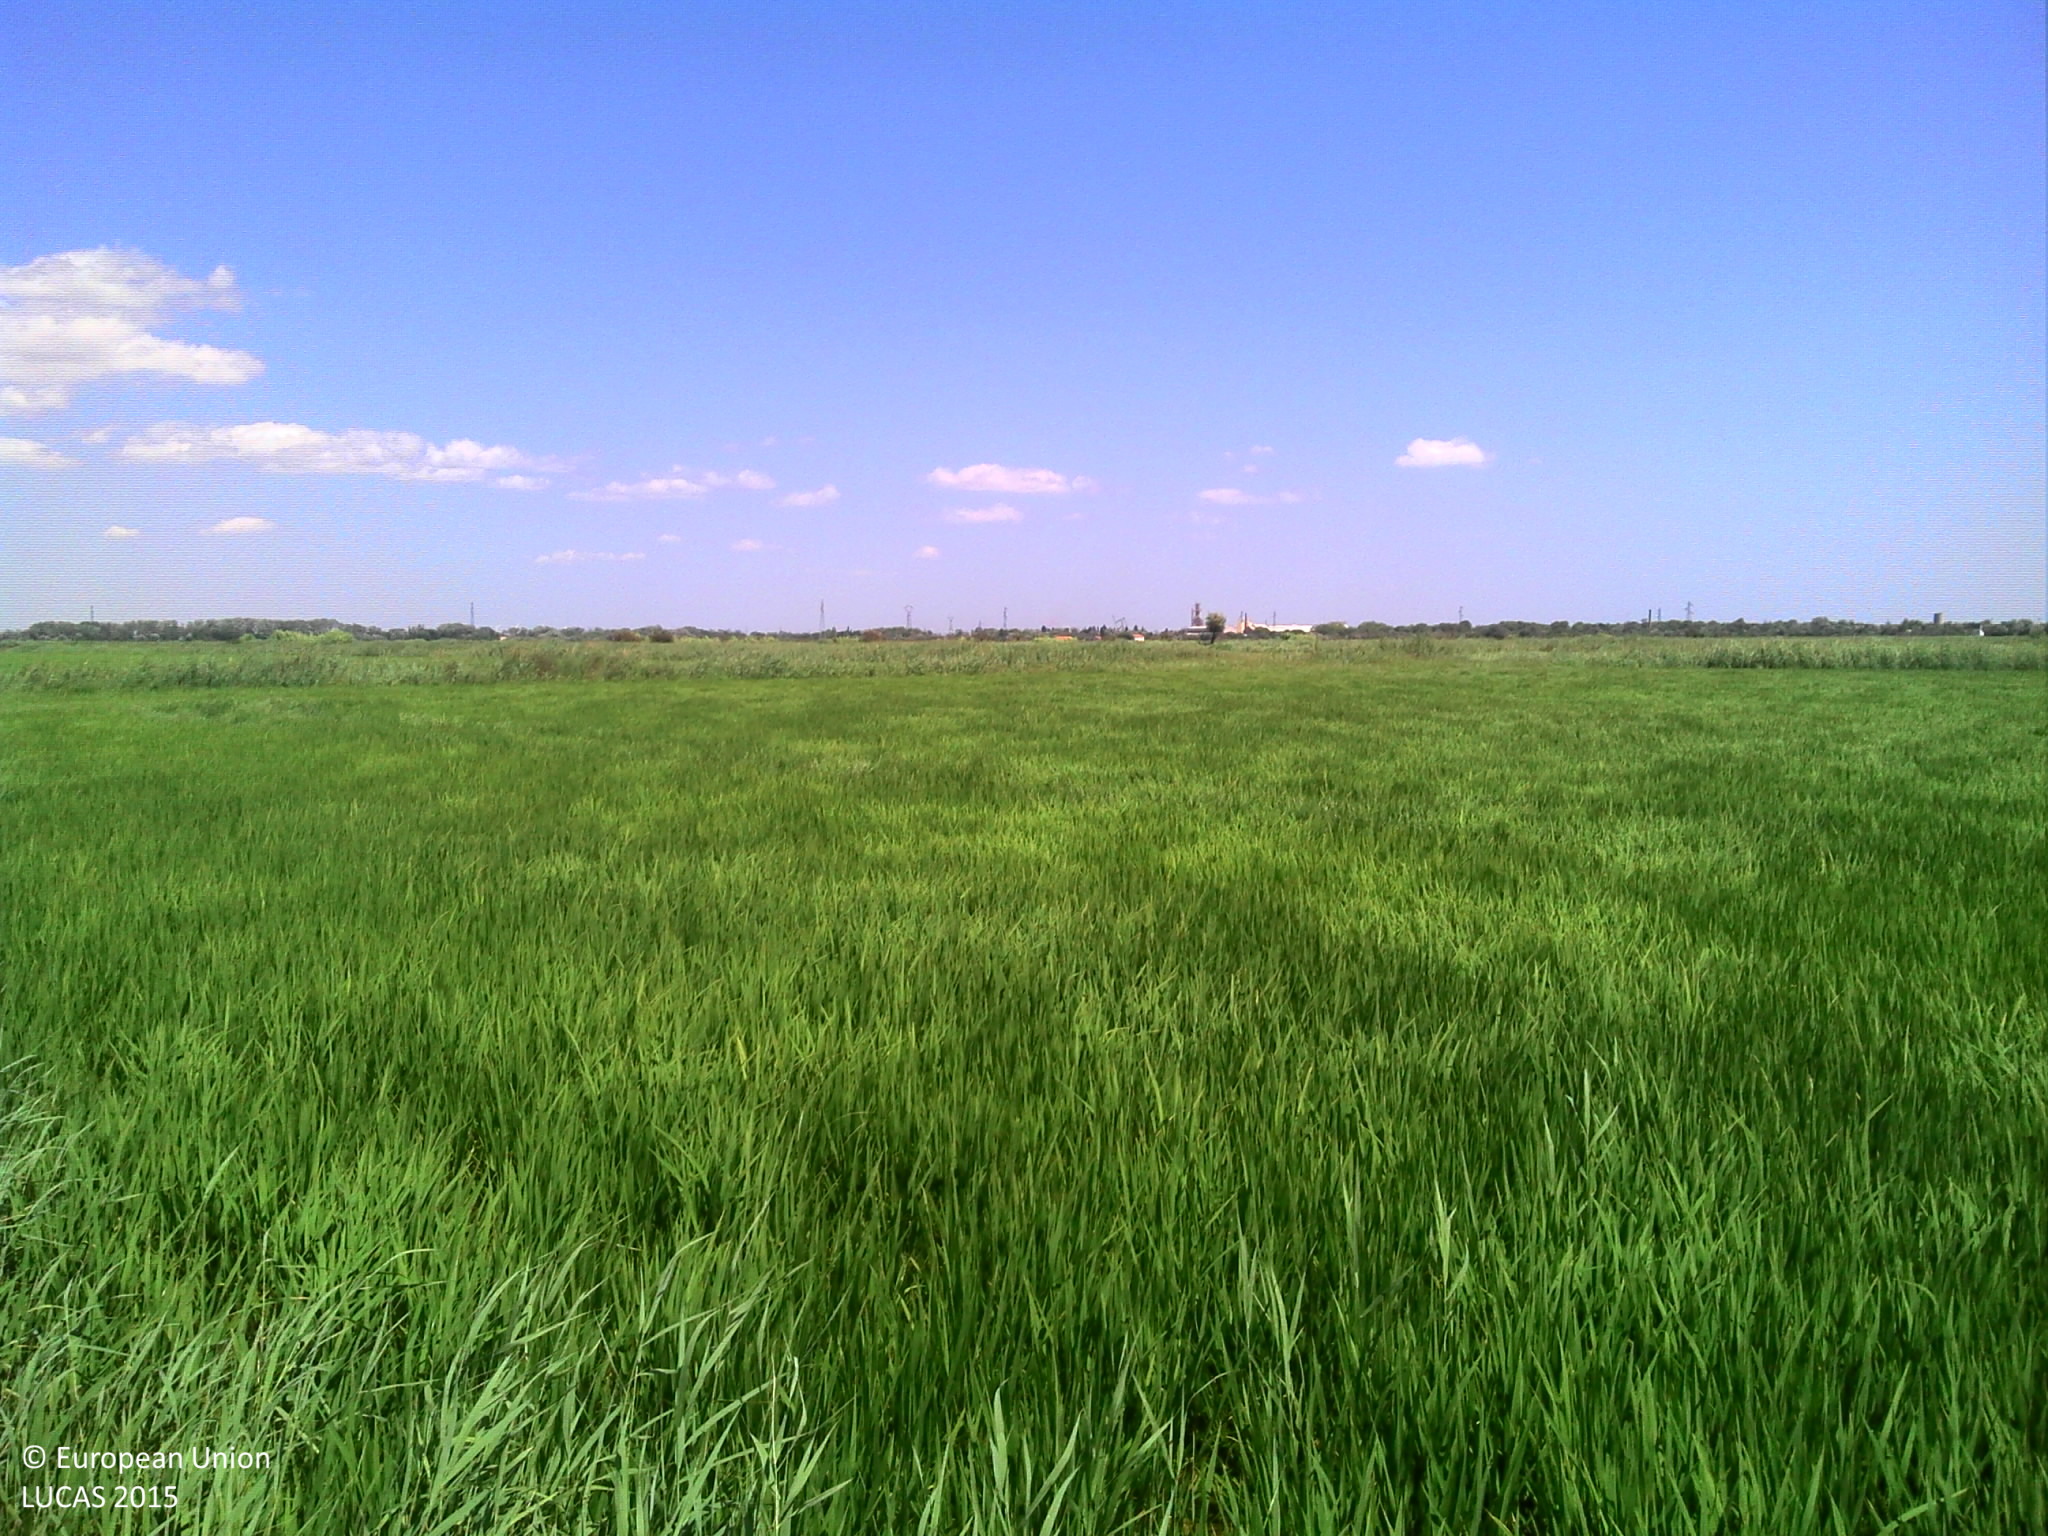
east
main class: Cropland
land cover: Rice
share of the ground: > 75 %
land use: Agriculture (excluding fallow land and kitchen gardens)
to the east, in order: Rice; Spontaneously vegetated surfaces; Ditches and canals; Rice; Spontaneously vegetated surfaces; Ditches and canals; Rice; Spontaneously vegetated surfaces; Ditches and canals; Rice
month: July
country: FR
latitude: 43.4203
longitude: 4.7116
